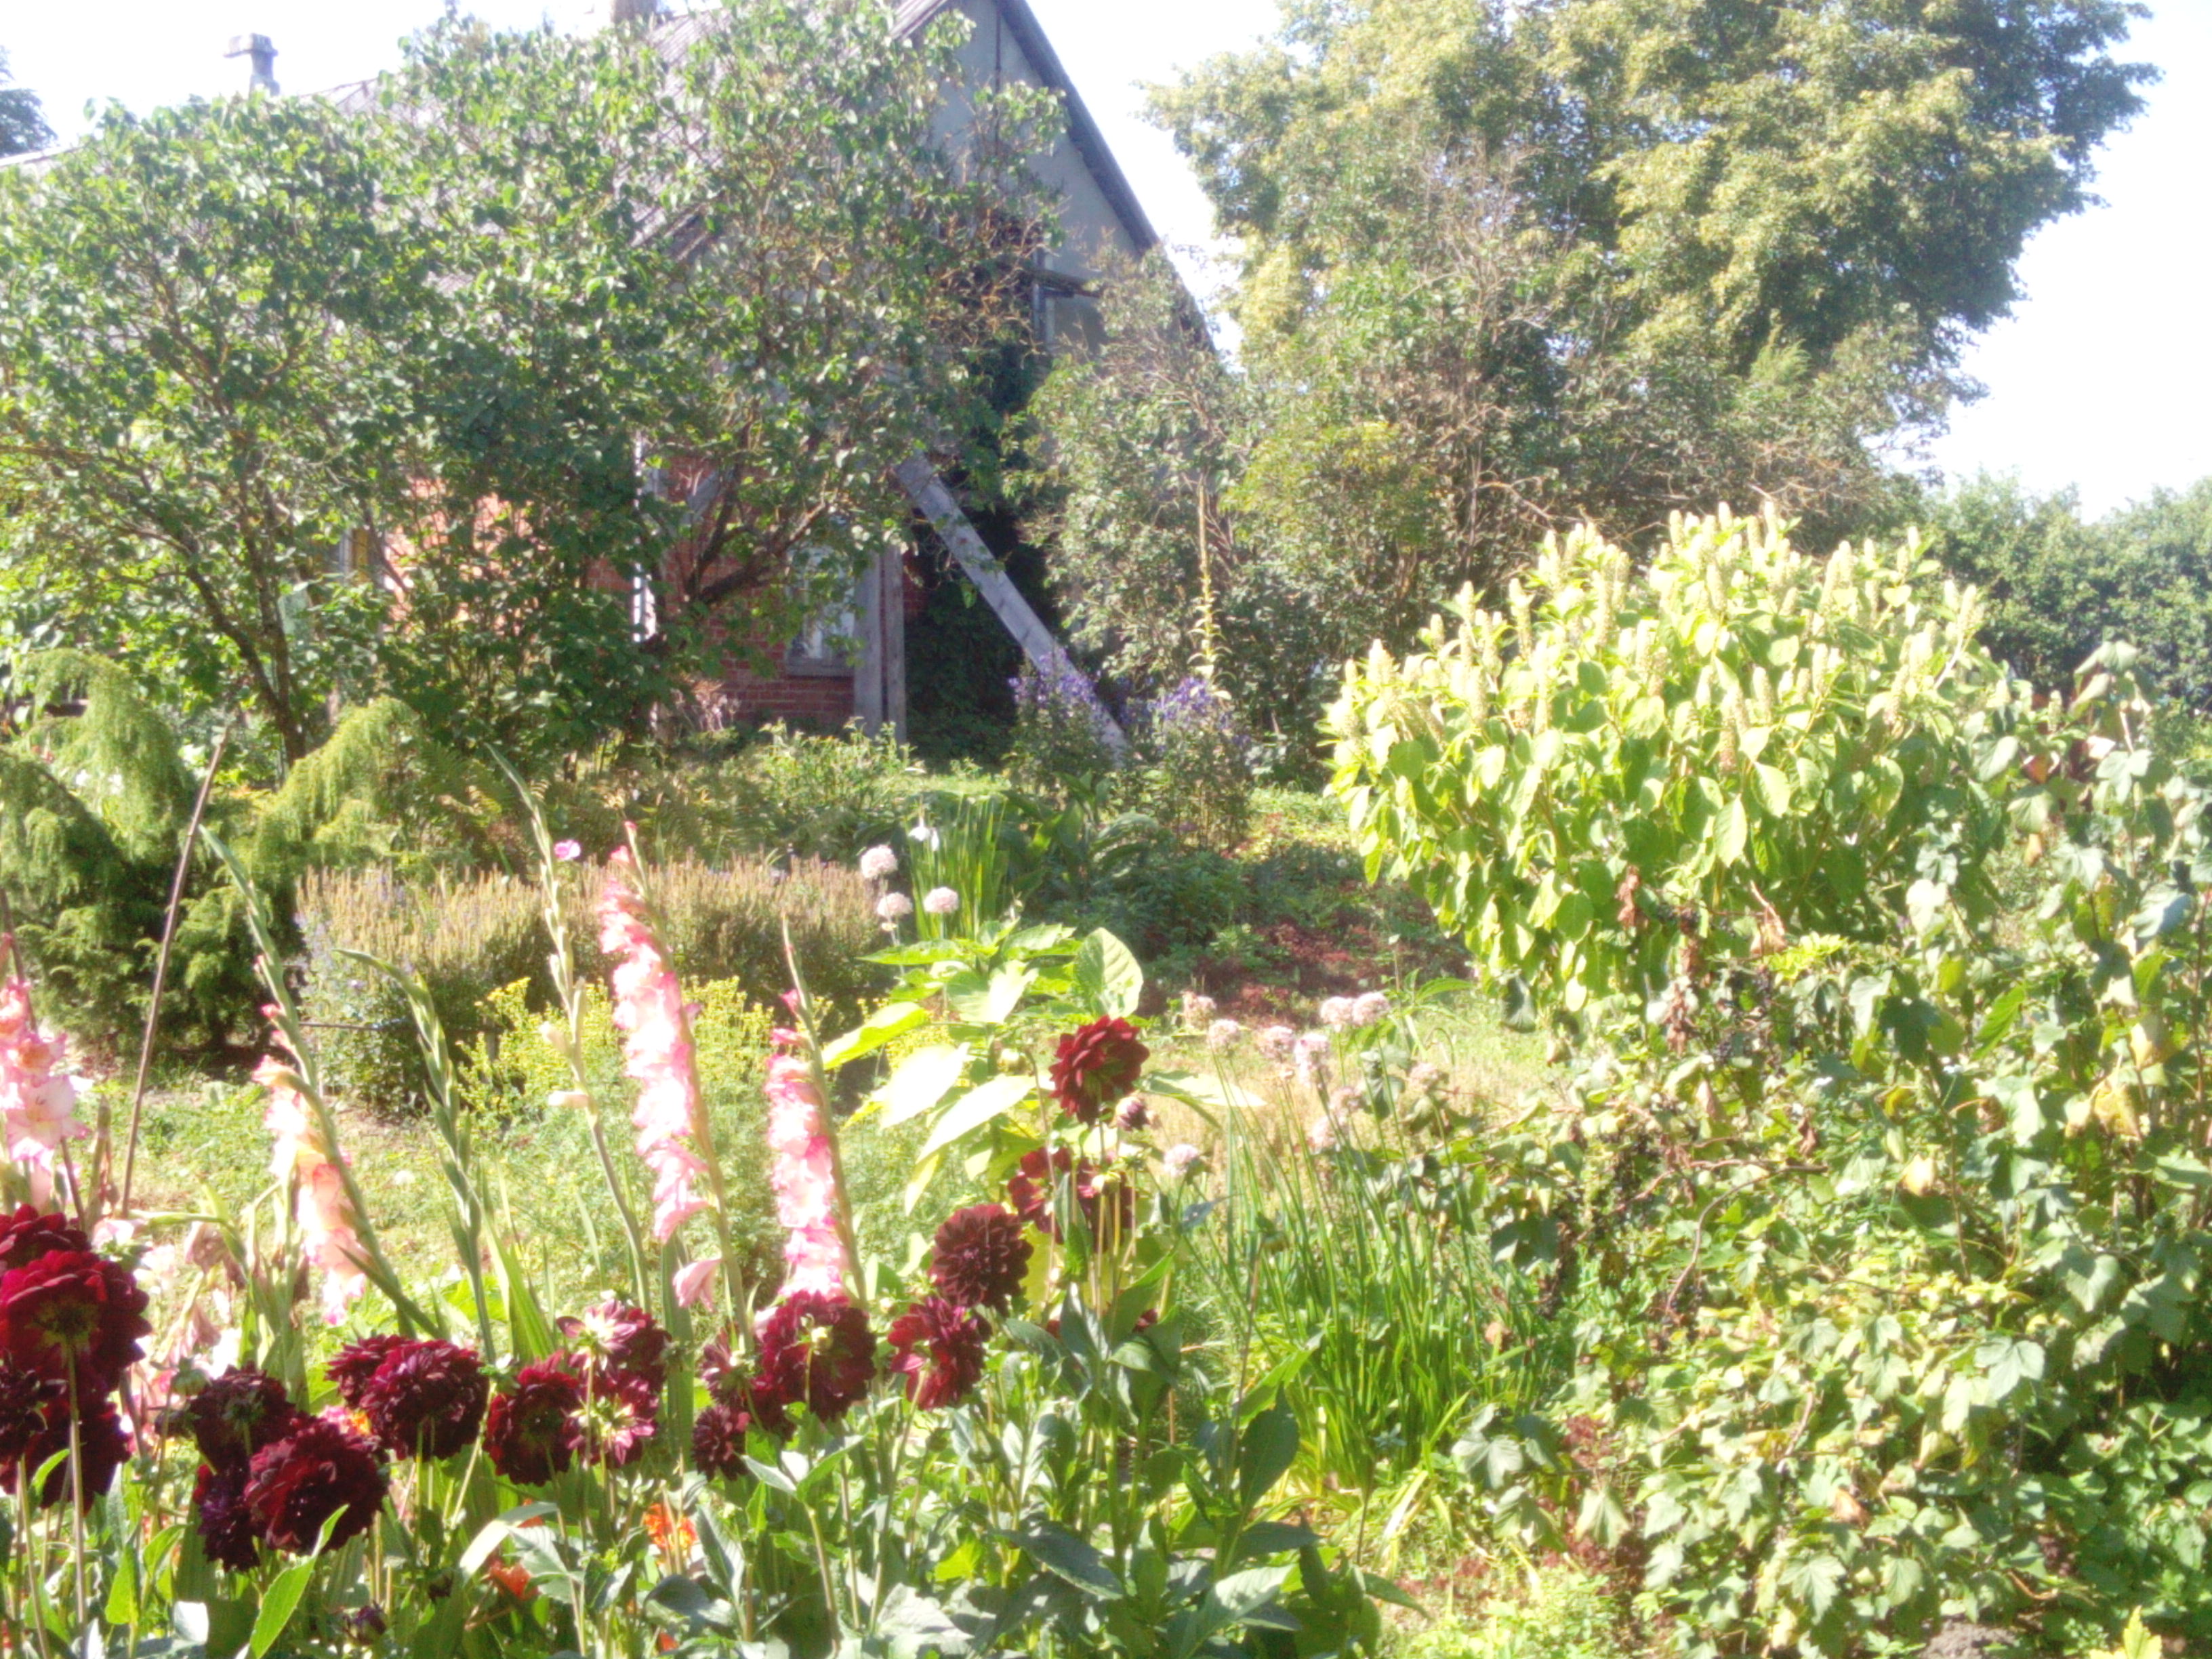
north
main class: Cropland
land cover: Apple fruit
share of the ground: 25 - 50 %
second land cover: Grassland without tree/shrub cover
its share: > 75 %
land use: Kitchen garden
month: August
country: LV
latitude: 56.6103
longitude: 21.1323
